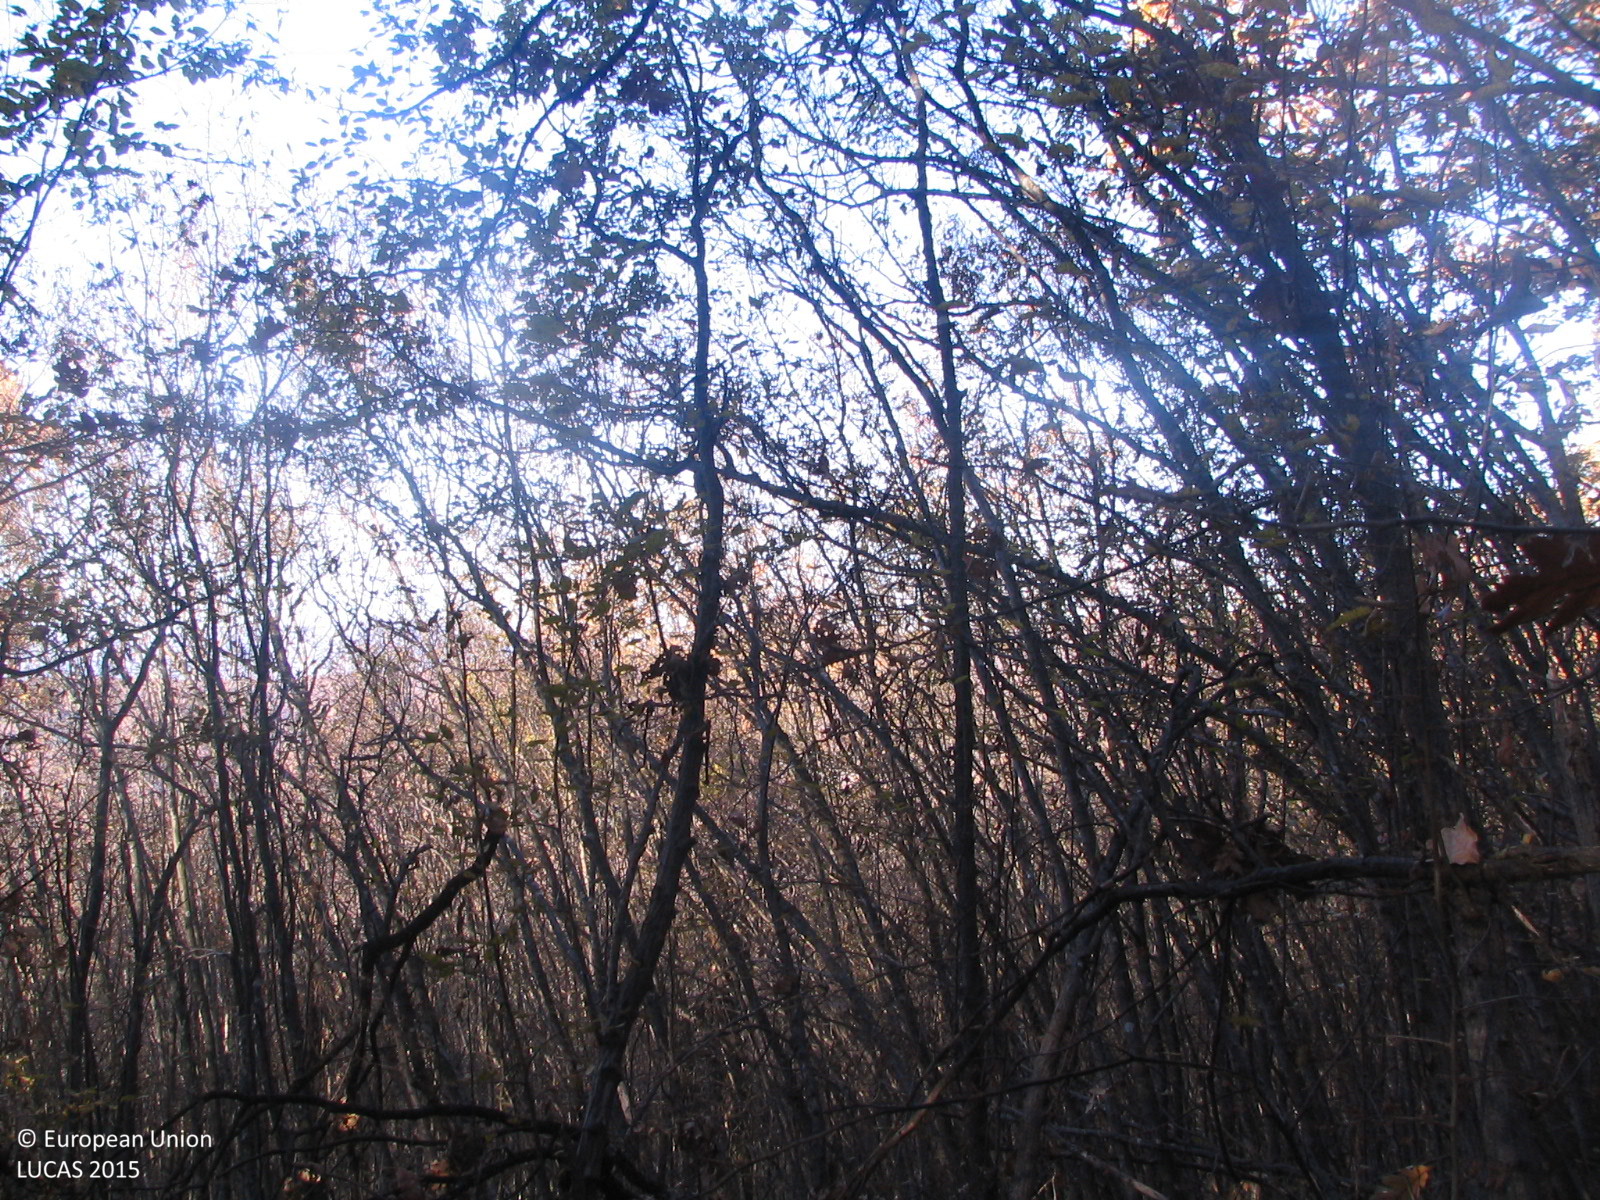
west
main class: Woodland
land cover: Broadleaved woodland
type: acidophilous oak and oak-birch forest
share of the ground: > 75 %
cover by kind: broadleaved forest trees 90 %, shrubs 5 %, herbaceous plants 5 %
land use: Forestry
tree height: > 5 m
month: November
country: BG
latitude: 43.0067
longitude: 23.7722
